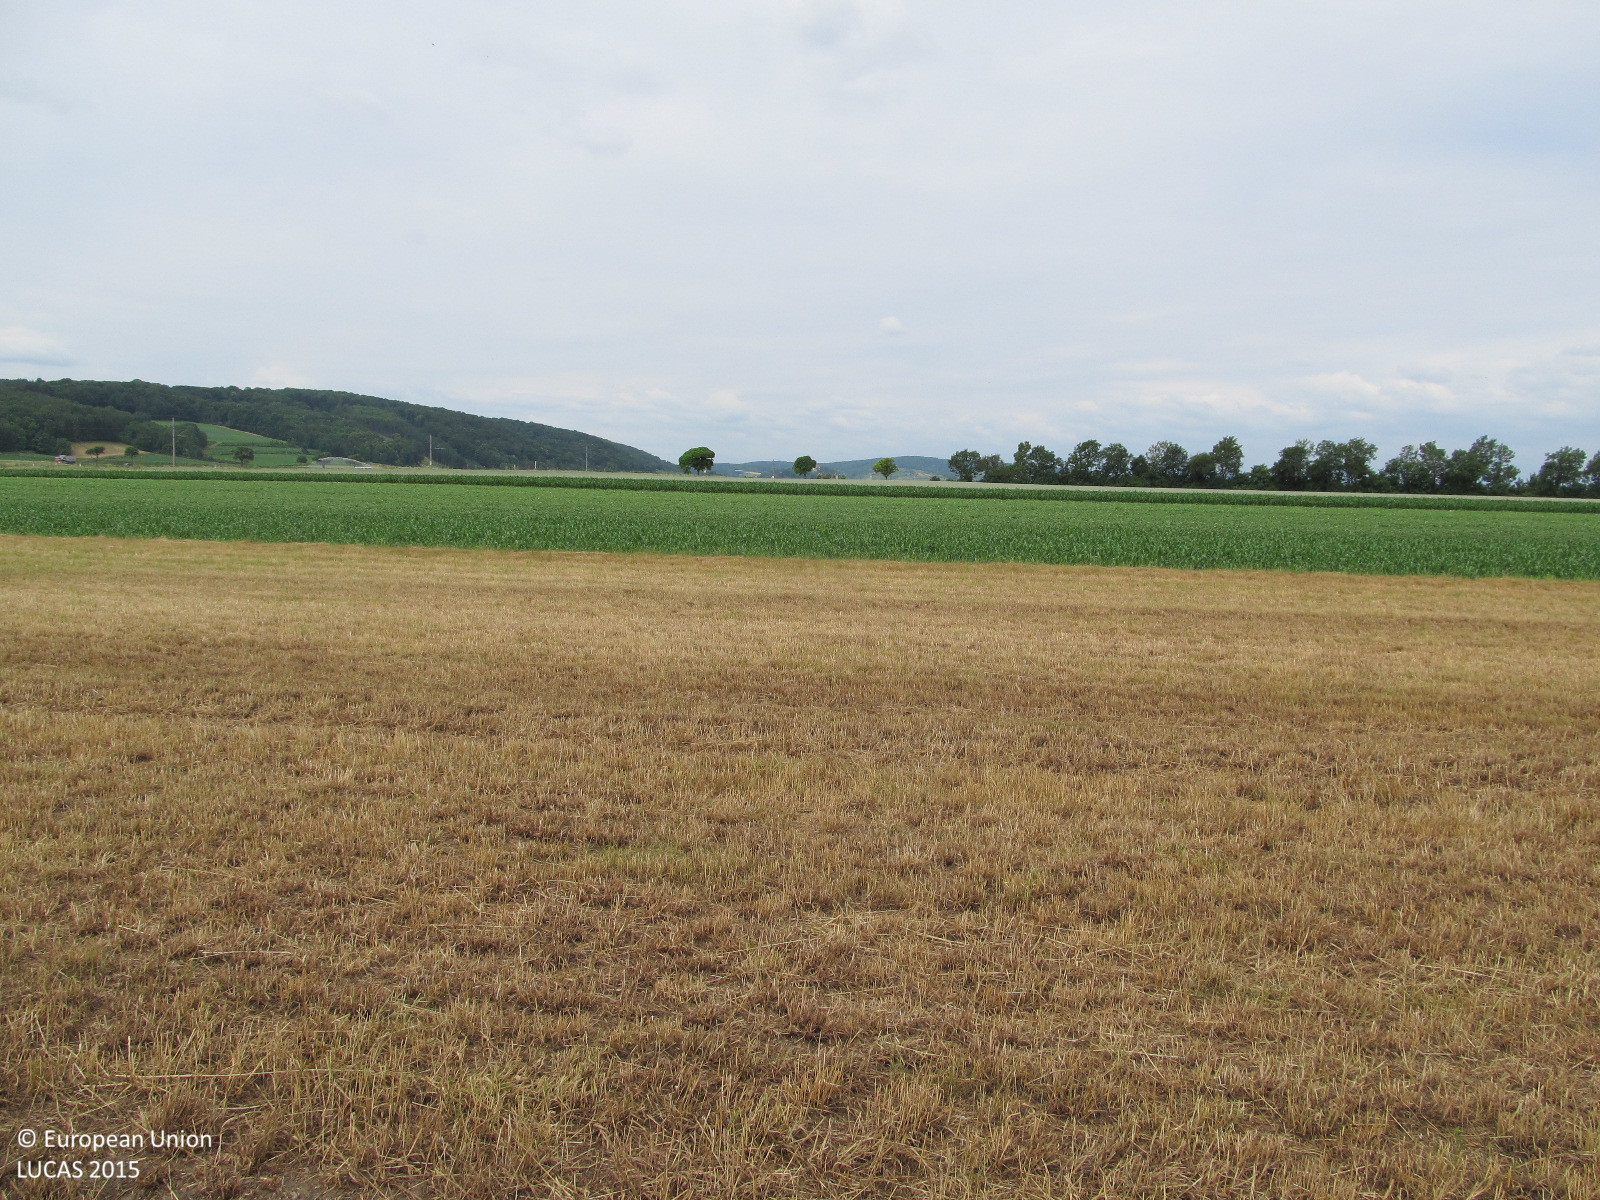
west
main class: Grassland
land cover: Grassland without tree/shrub cover
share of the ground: > 75 %
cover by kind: herbaceous plants 100 %
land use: Agriculture (excluding fallow land and kitchen gardens)
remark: Harvested field
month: June
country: AT
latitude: 48.3197
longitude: 15.8699
